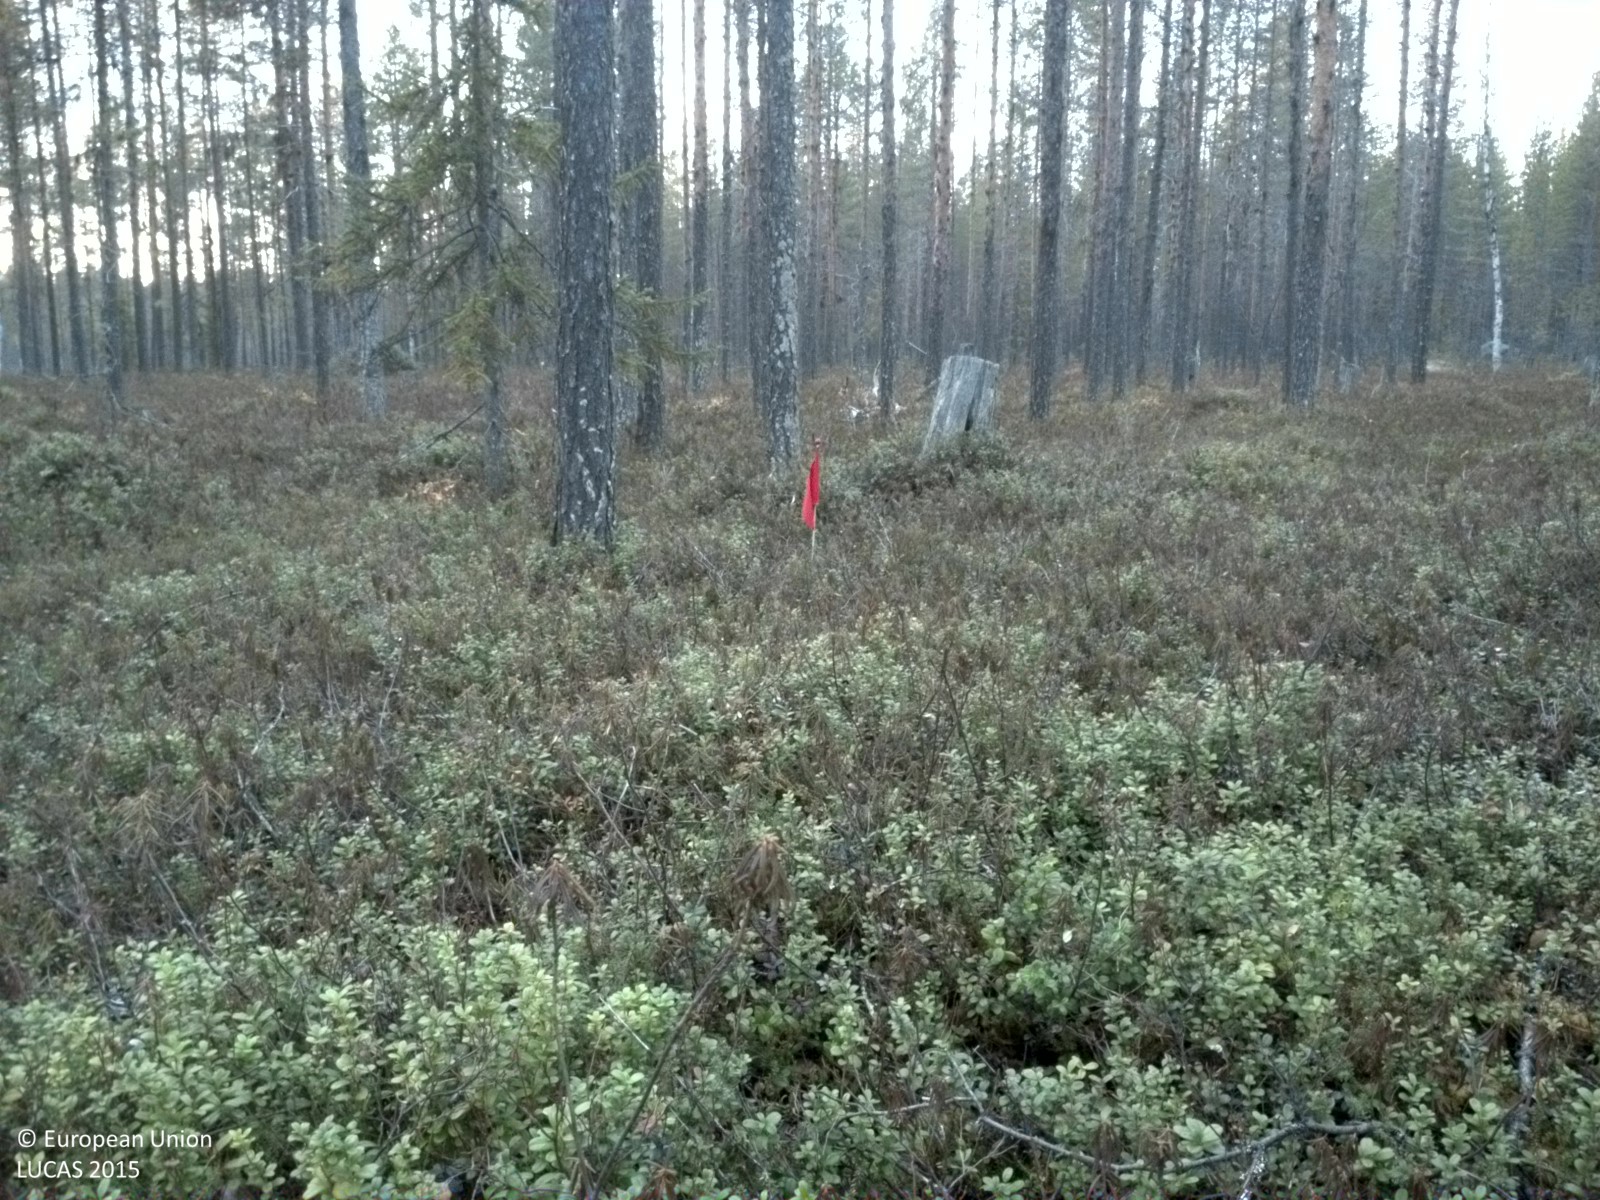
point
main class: Woodland
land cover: Pine dominated coniferous woodland
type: boreal forest
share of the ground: 25 - 50 %
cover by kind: shrubs 70 %, coniferous forest trees 30 %
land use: Forestry
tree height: > 5 m
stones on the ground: > 50 %
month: October
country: SE
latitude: 65.8776
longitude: 20.4665
